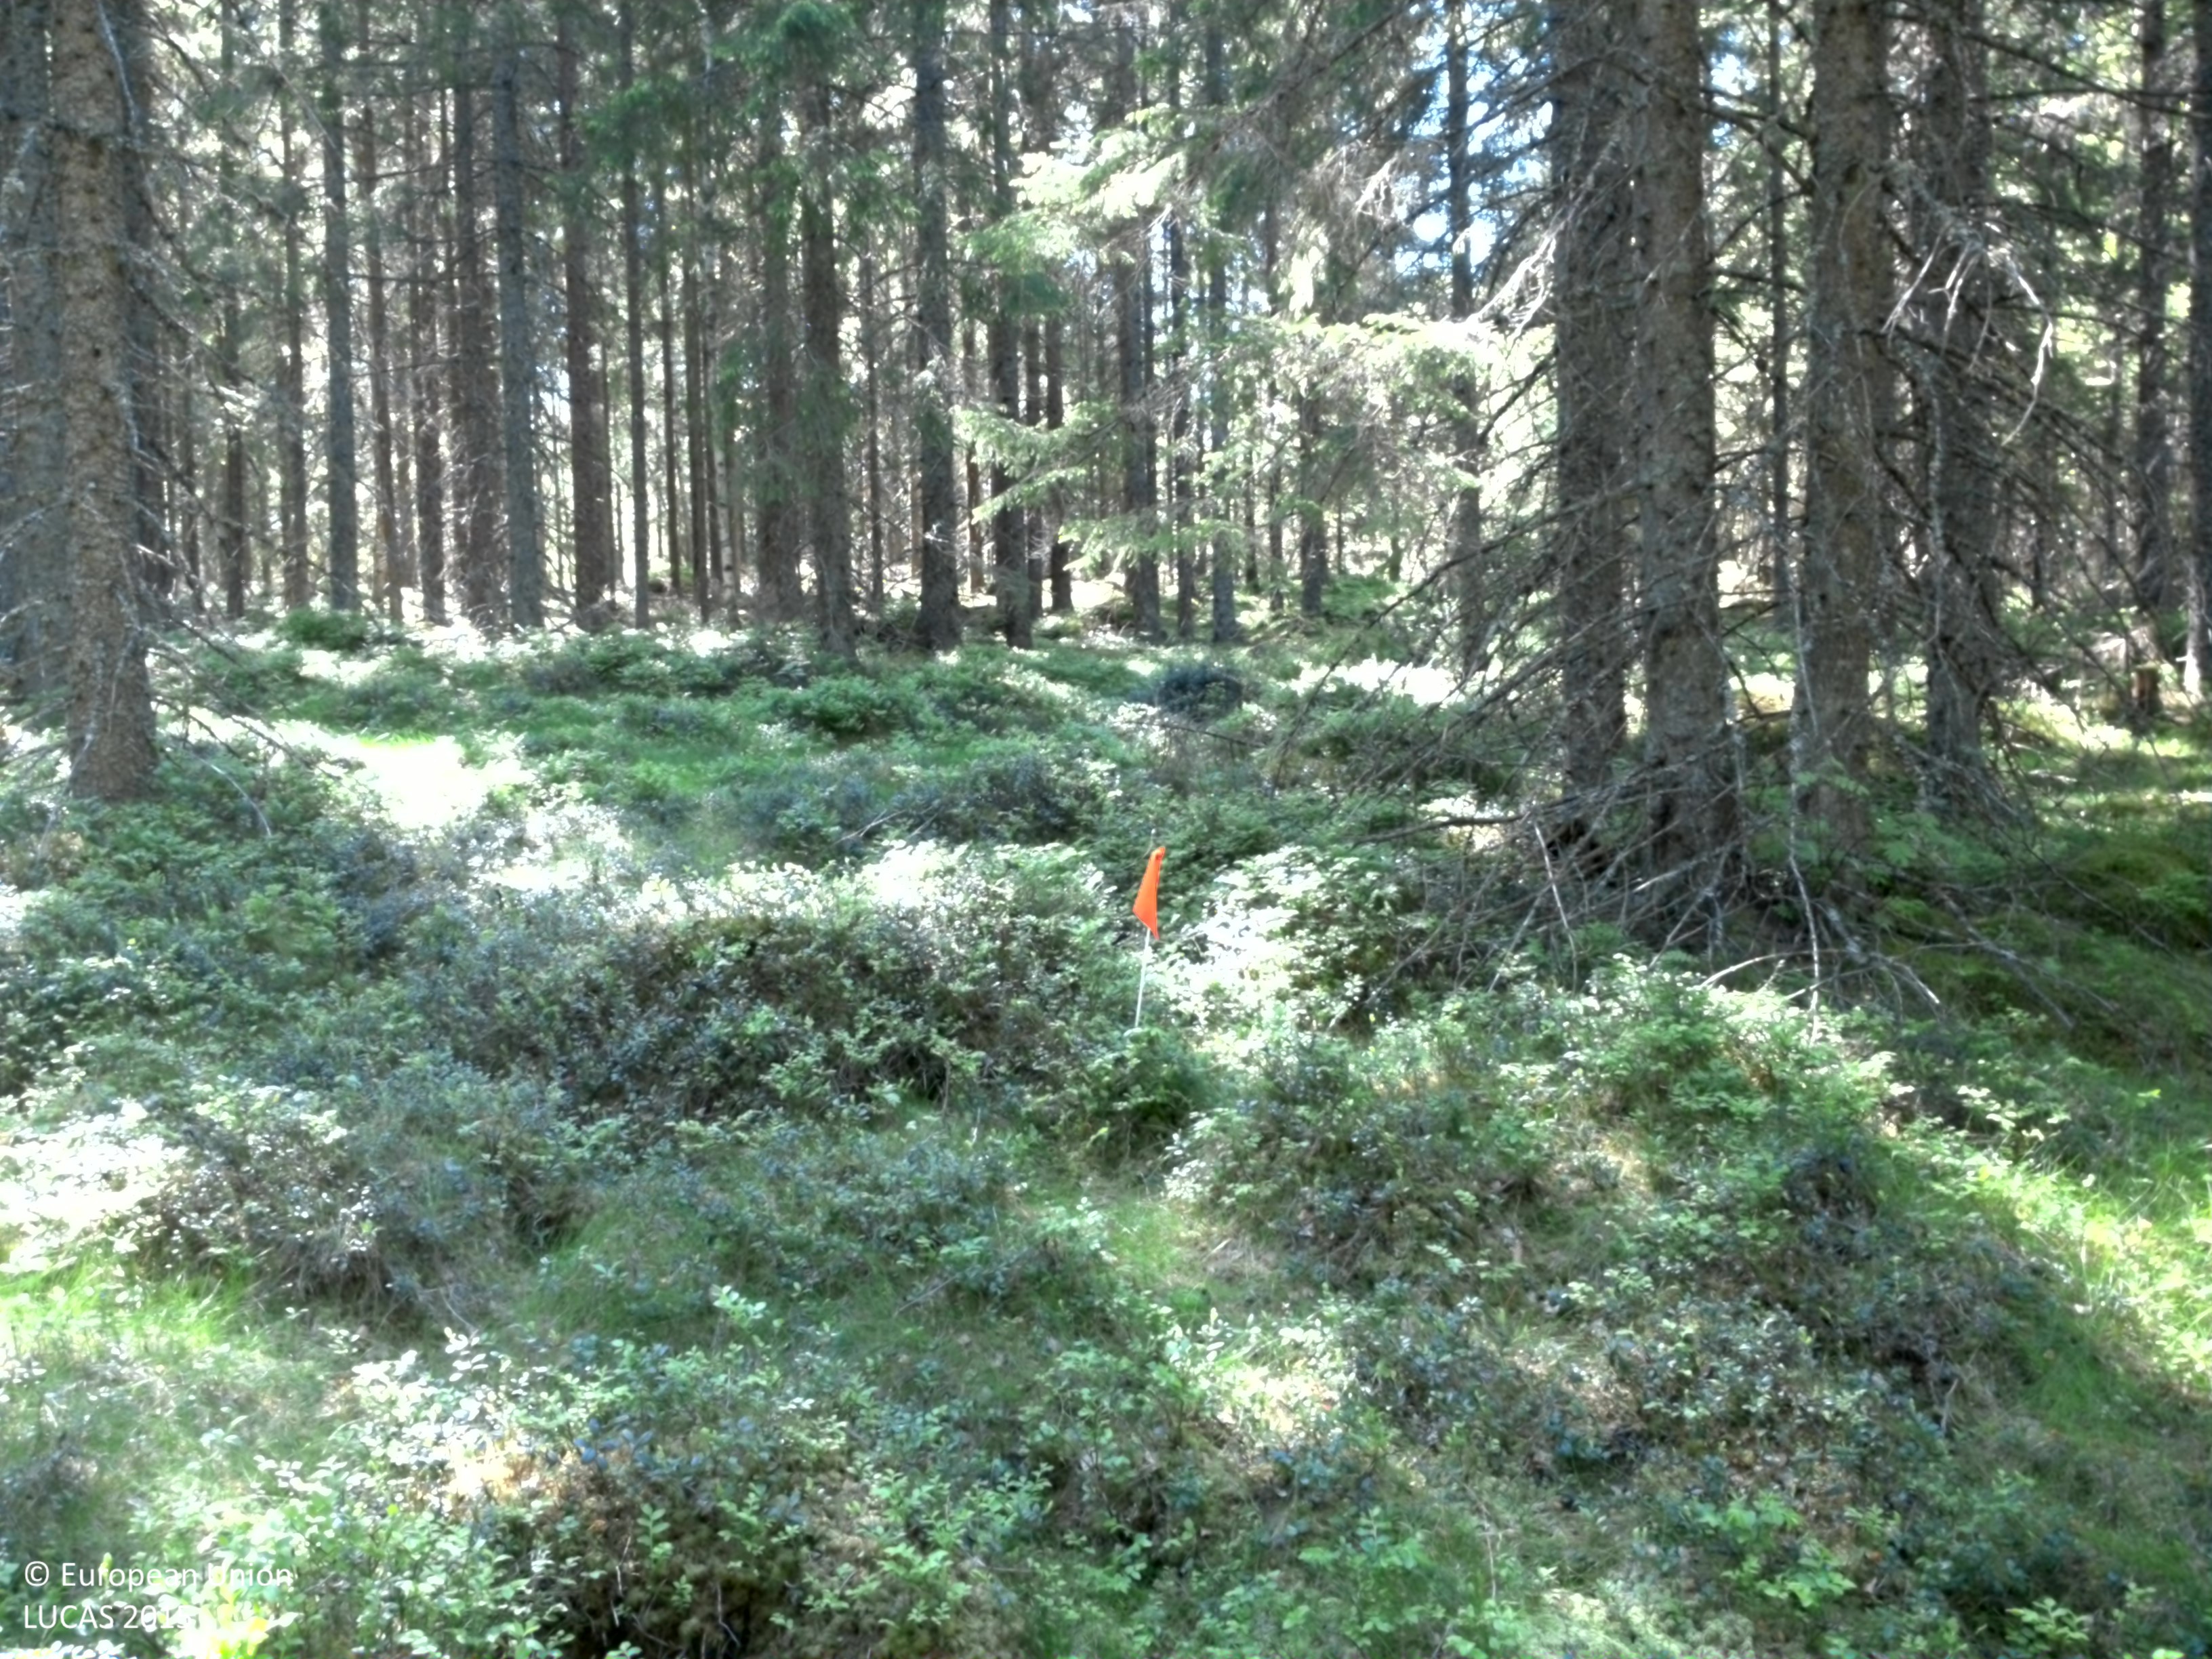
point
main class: Woodland
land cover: Spruce dominated coniferous woodland
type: boreal forest
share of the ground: > 75 %
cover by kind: coniferous forest trees 65 %, shrubs 15 %, broadleaved forest trees 10 %, herbaceous plants 5 %, lichens and mosses 5 %
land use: Forestry
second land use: Community services
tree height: > 5 m
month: June
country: SE
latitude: 59.3443
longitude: 14.7213
